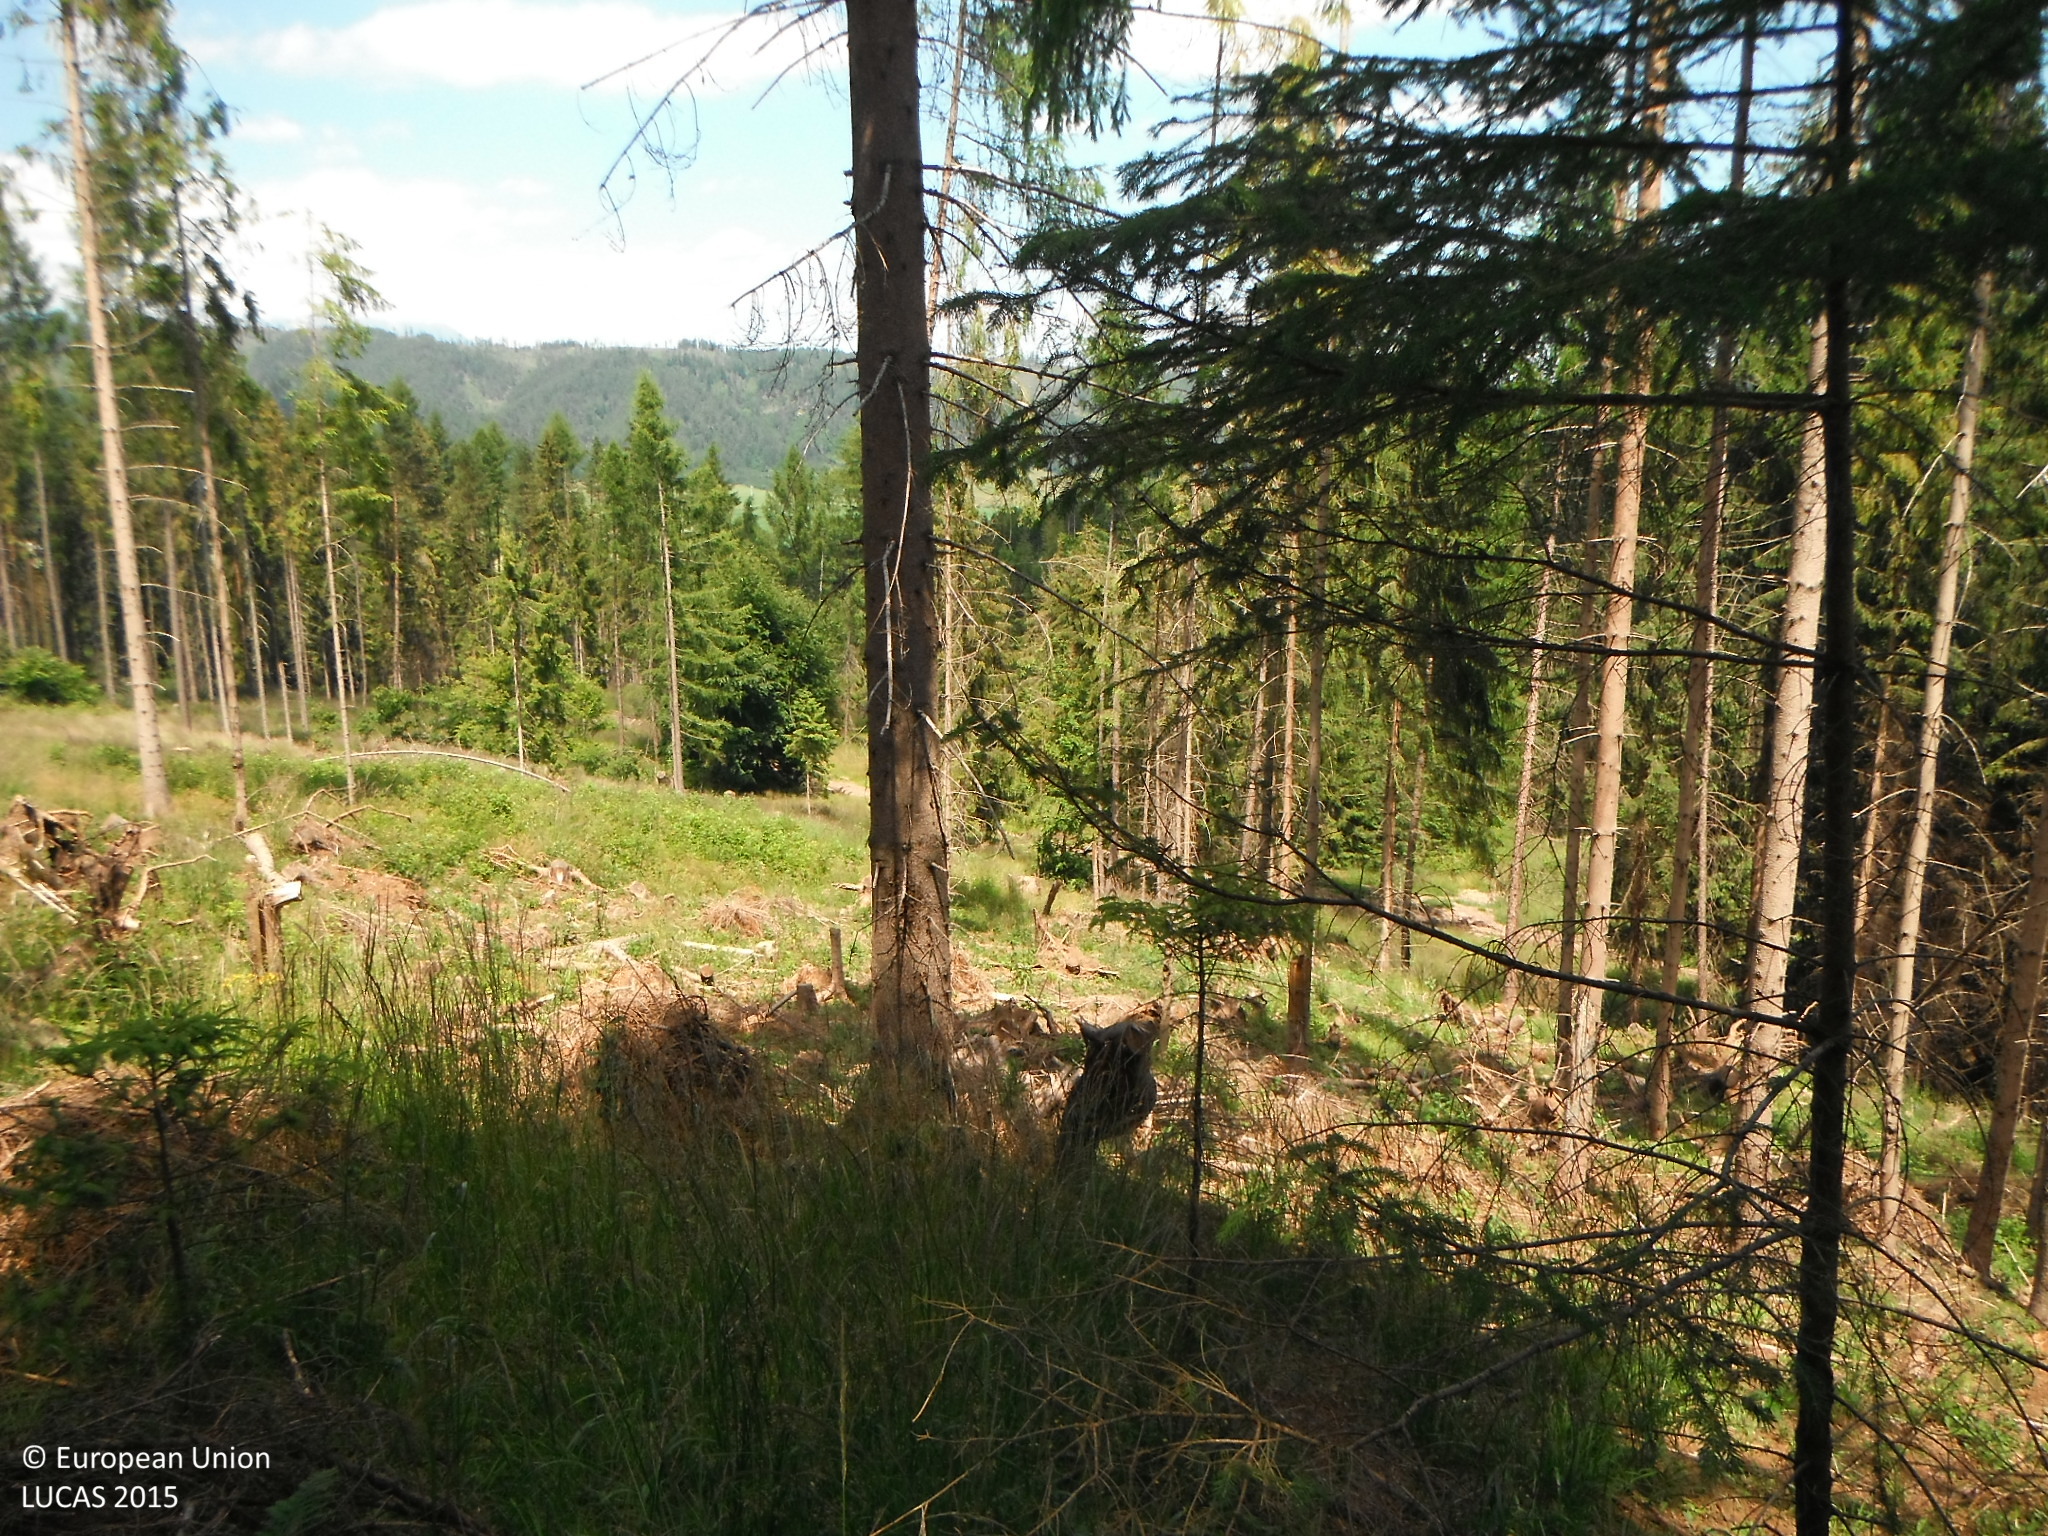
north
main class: Woodland
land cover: Spruce dominated coniferous woodland
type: alpine coniferous forest
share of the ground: > 75 %
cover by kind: coniferous forest trees 85 %, consolidated bare surface 10 %, lichens and mosses 5 %
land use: Forestry
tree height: > 5 m
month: July
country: SK
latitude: 48.9812
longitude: 20.2123
